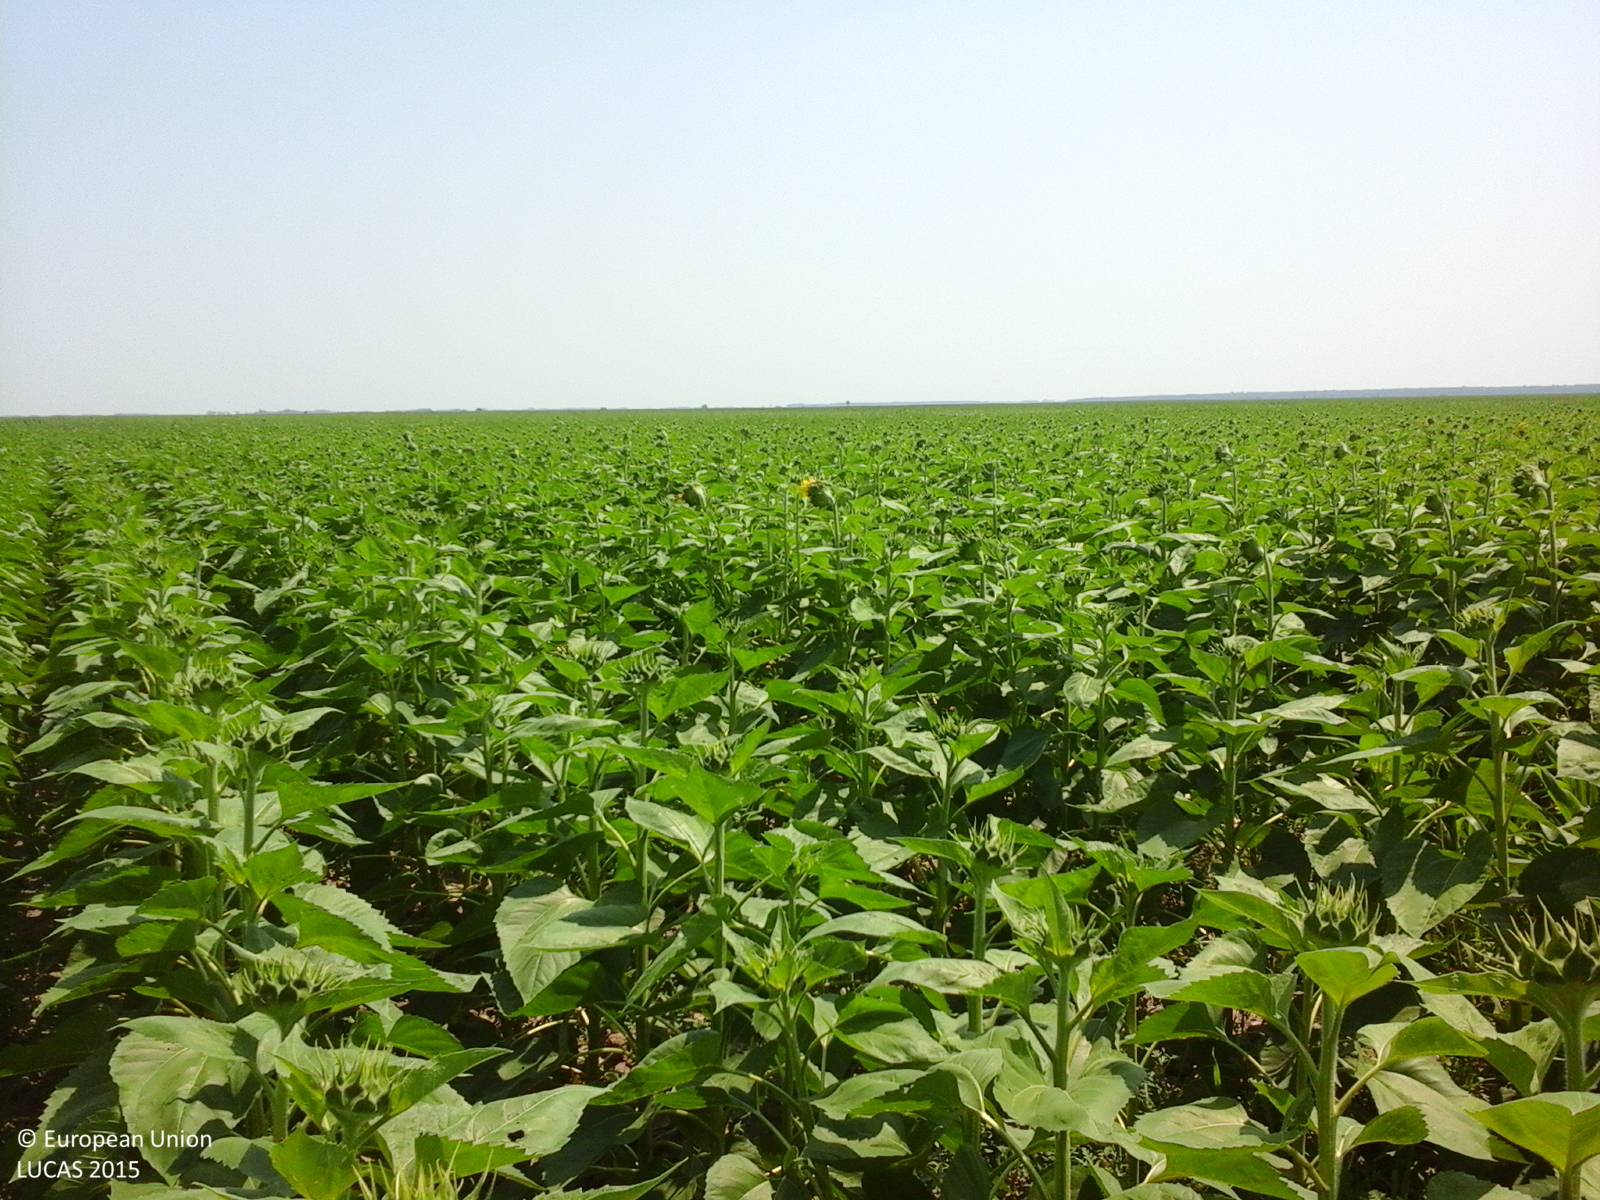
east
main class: Cropland
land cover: Sunflower
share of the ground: > 75 %
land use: Agriculture (excluding fallow land and kitchen gardens)
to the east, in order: Sunflower; Tracks; Sunflower
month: July
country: RO
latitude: 44.7569
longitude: 25.7259
